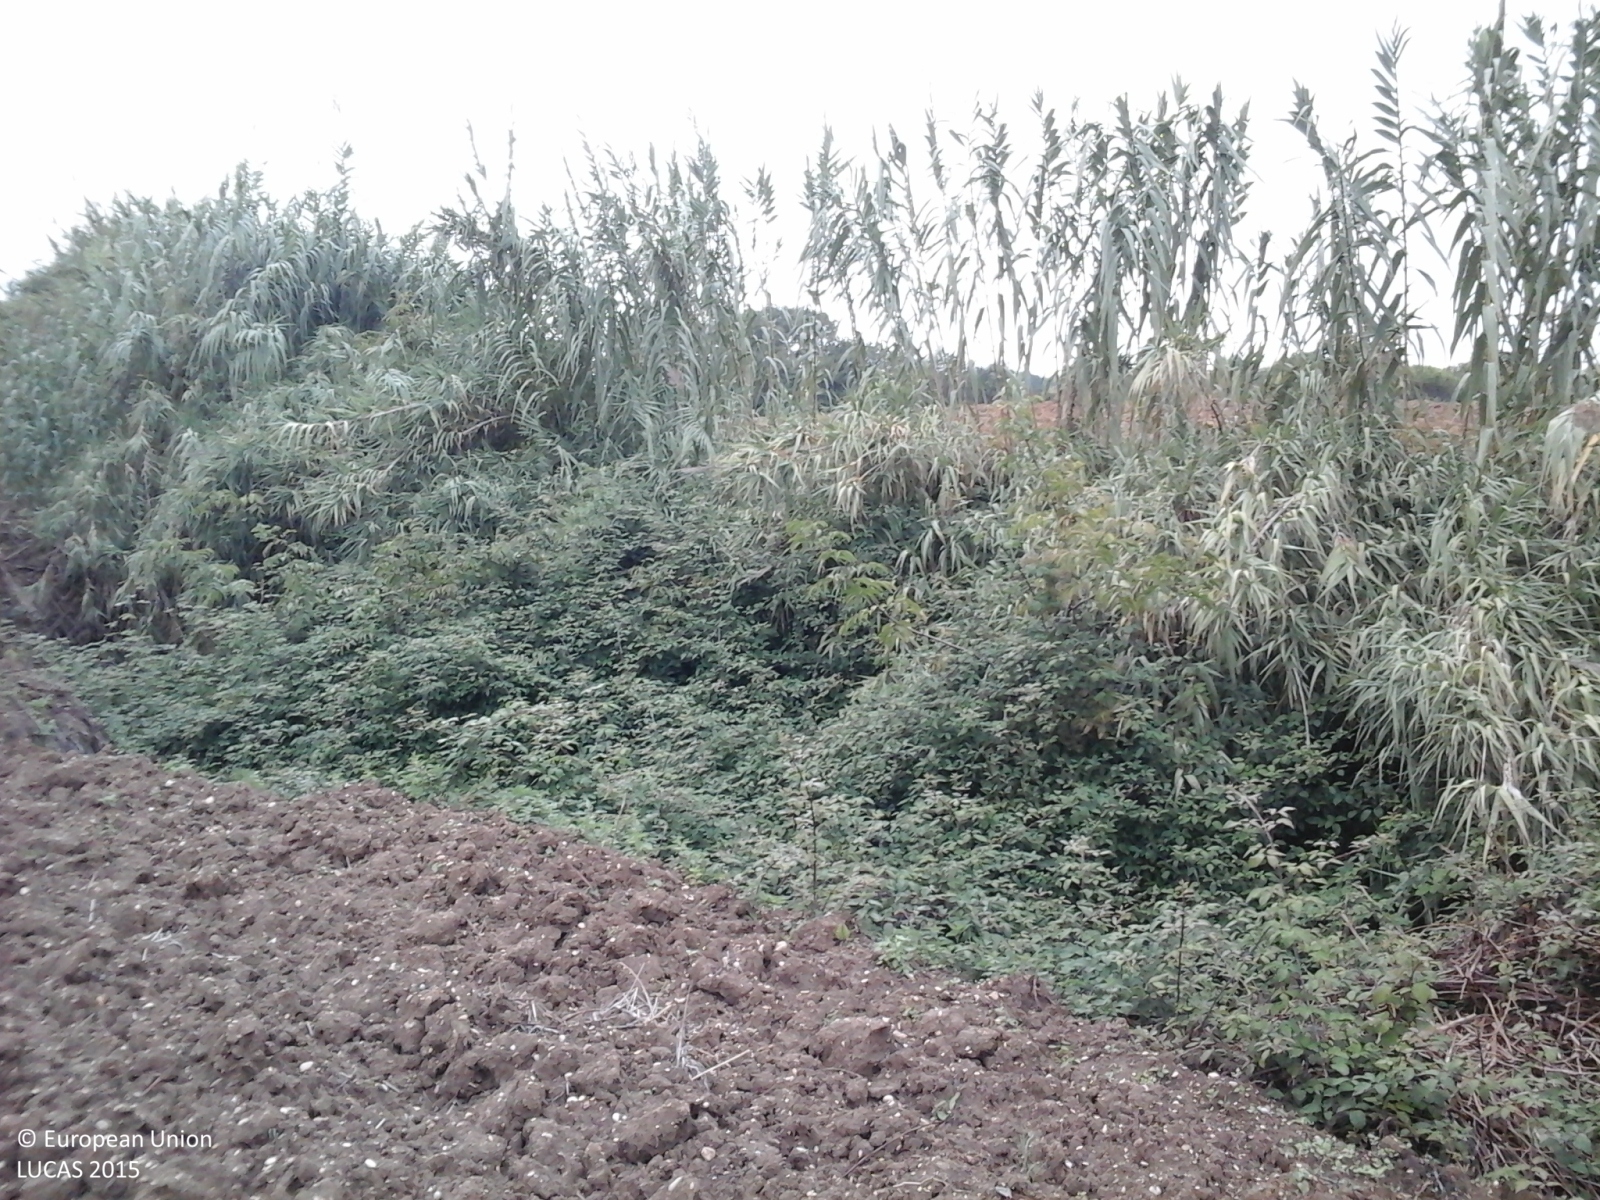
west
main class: Cropland
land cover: Durum wheat
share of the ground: < 10 %
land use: Agriculture (excluding fallow land and kitchen gardens)
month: October
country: IT
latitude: 43.5170
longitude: 13.4431
